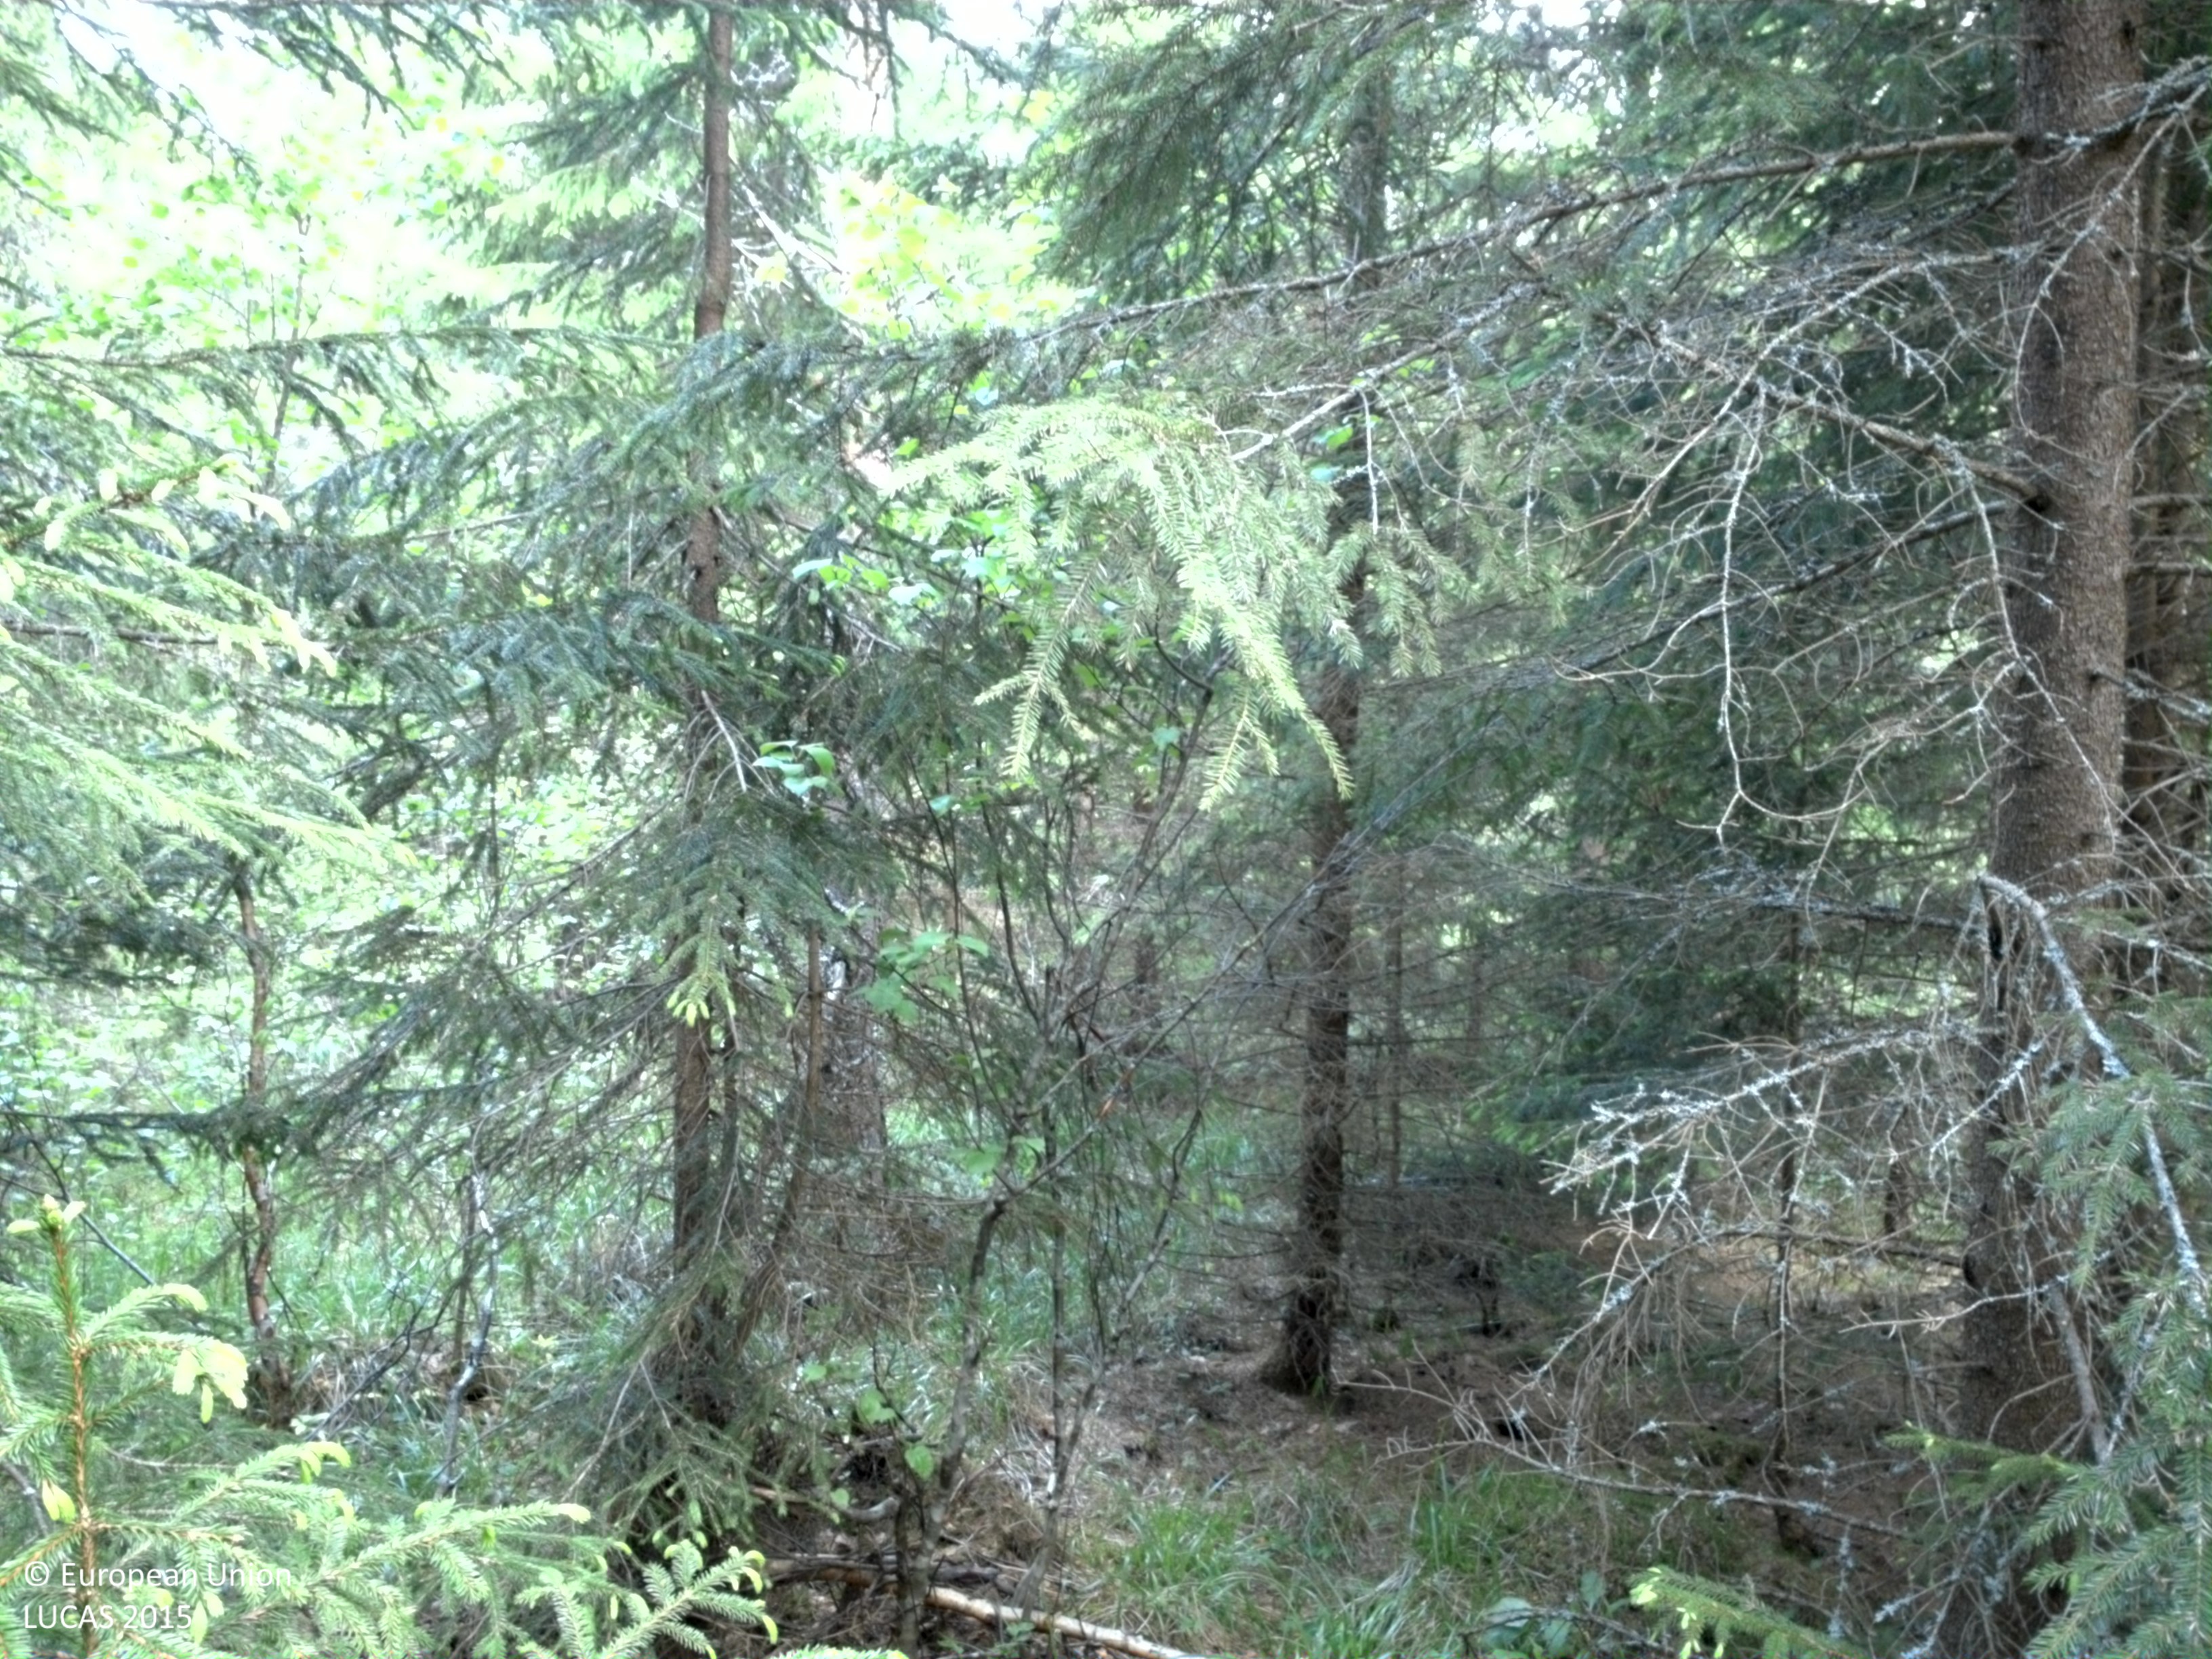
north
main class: Woodland
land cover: Spruce dominated mixed woodland
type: boreal forest
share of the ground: 50 - 75 %
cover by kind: coniferous forest trees 50 %, herbaceous plants 25 %, broadleaved forest trees 20 %, lichens and mosses 5 %
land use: Forestry
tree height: > 5 m
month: June
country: SE
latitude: 60.2393
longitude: 17.0525
